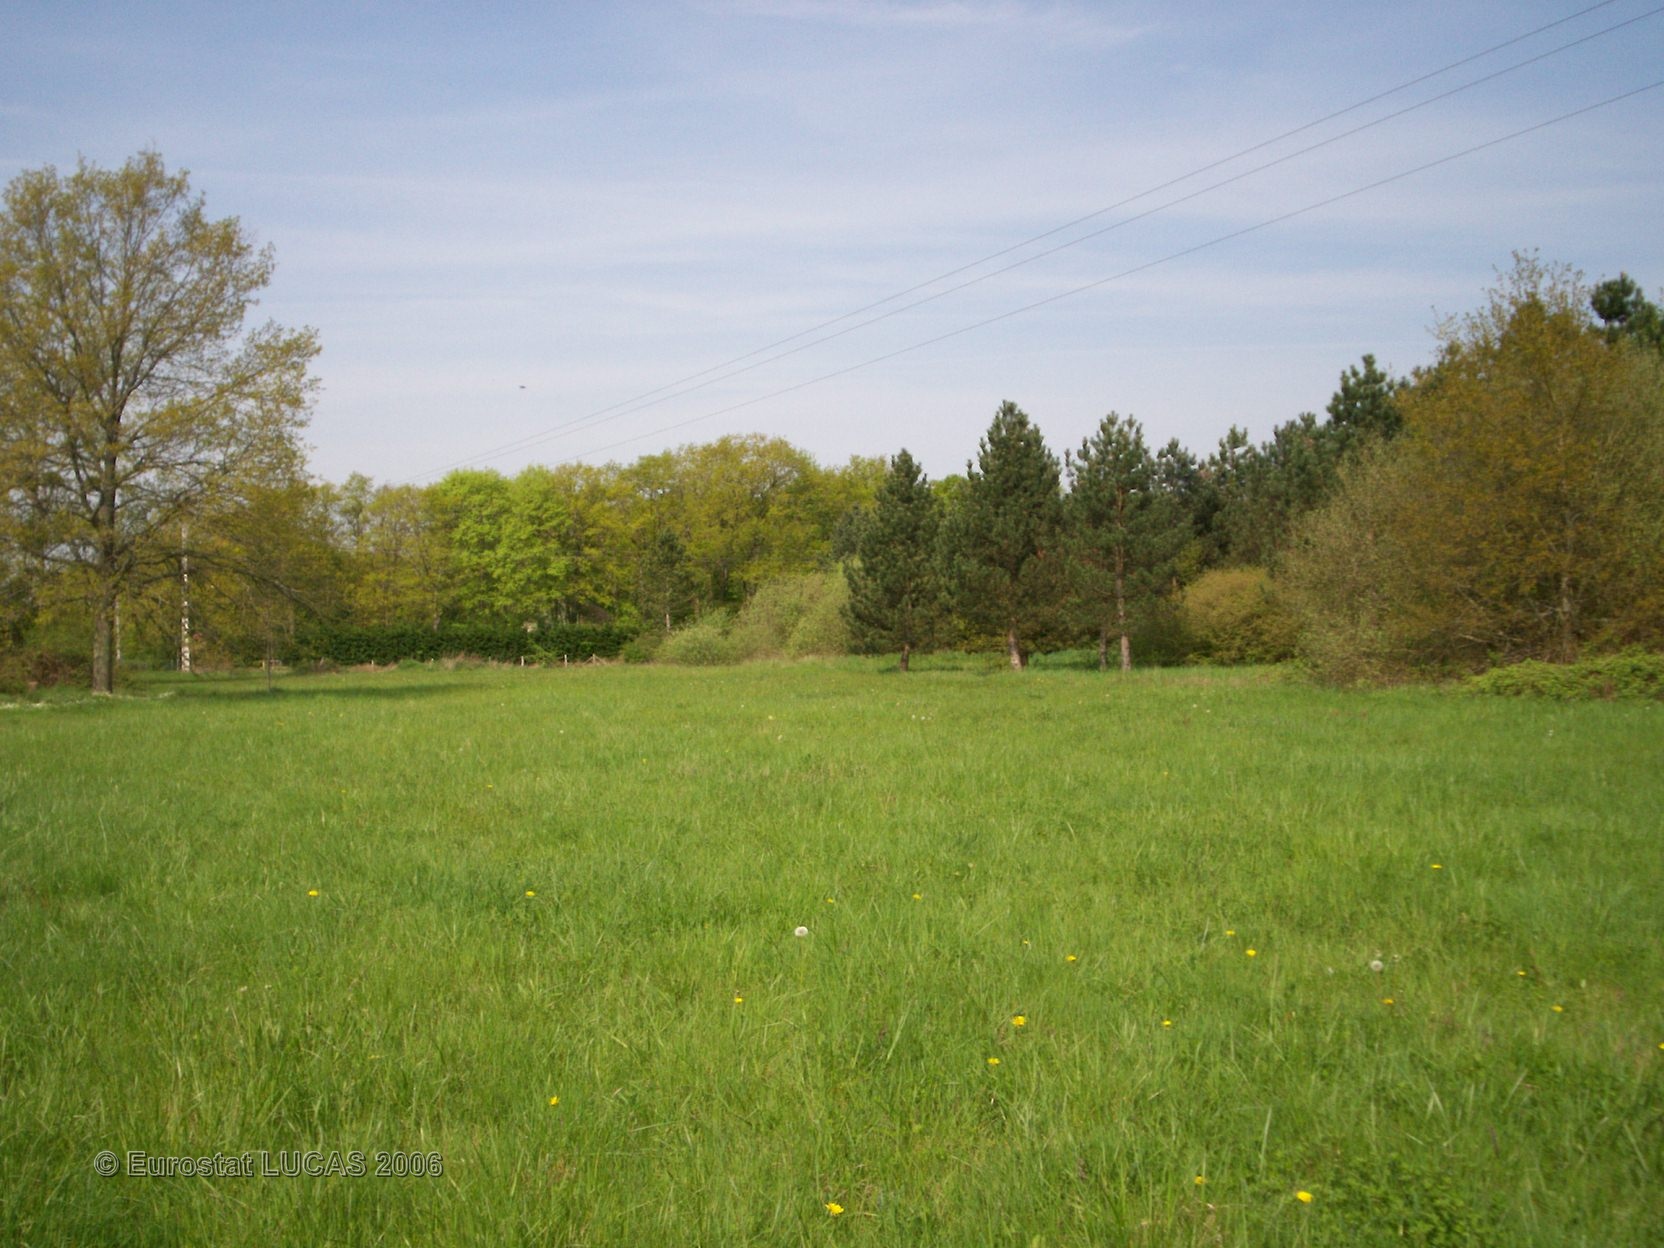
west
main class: Grassland
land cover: Grassland with sparse tree/shrub cover
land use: Agriculture (excluding fallow land and kitchen gardens)
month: May
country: FR
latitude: 48.0894
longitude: 2.9709
